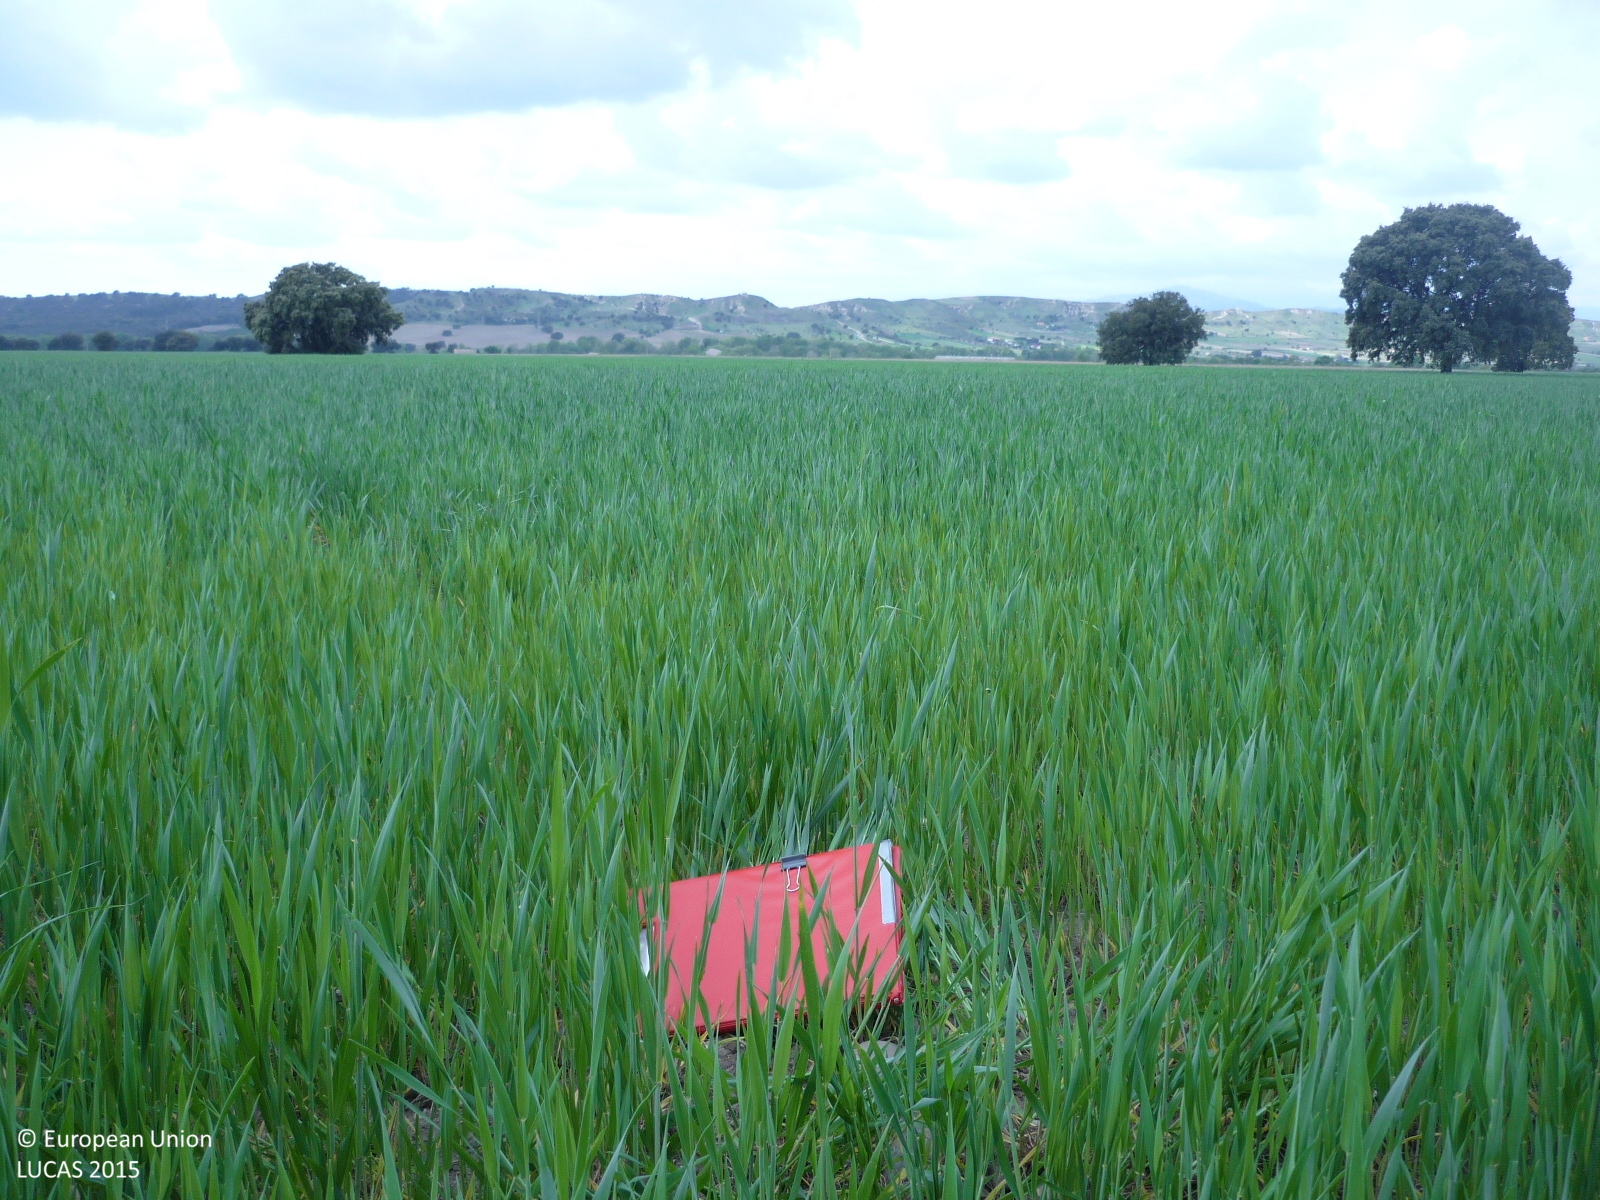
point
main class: Cropland
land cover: Common wheat
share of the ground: > 75 %
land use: Agriculture (excluding fallow land and kitchen gardens)
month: April
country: ES
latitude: 40.6615
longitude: -3.5344
